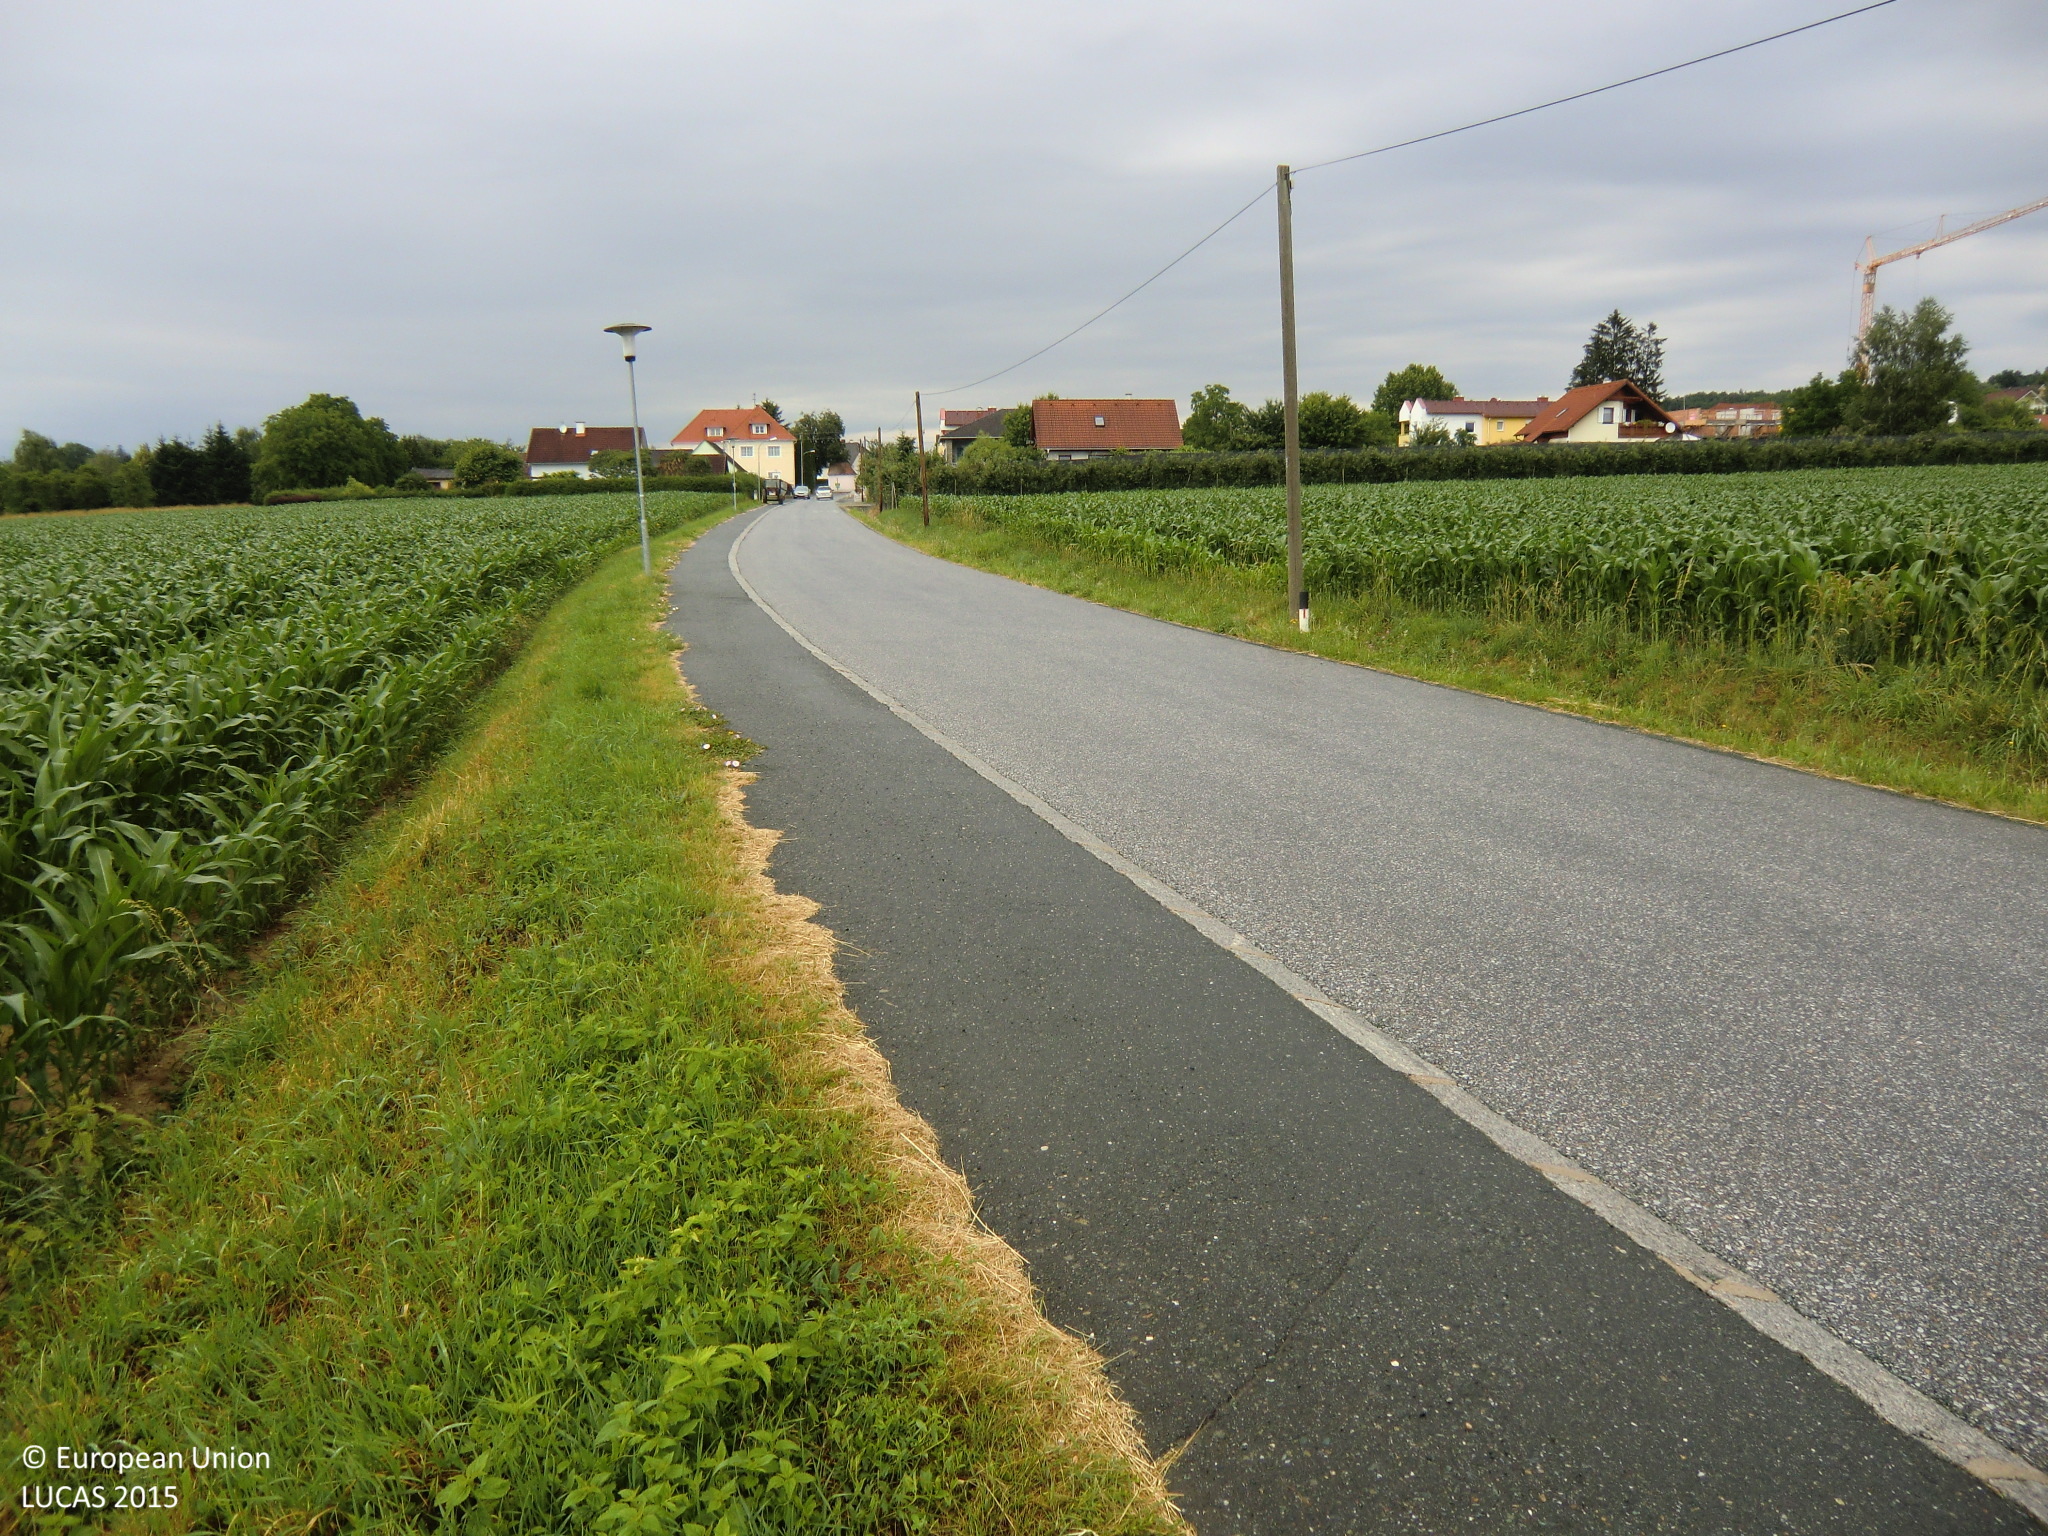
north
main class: Cropland
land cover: Maize
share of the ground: > 75 %
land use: Agriculture (excluding fallow land and kitchen gardens)
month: June
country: AT
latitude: 47.1697
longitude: 16.1100
